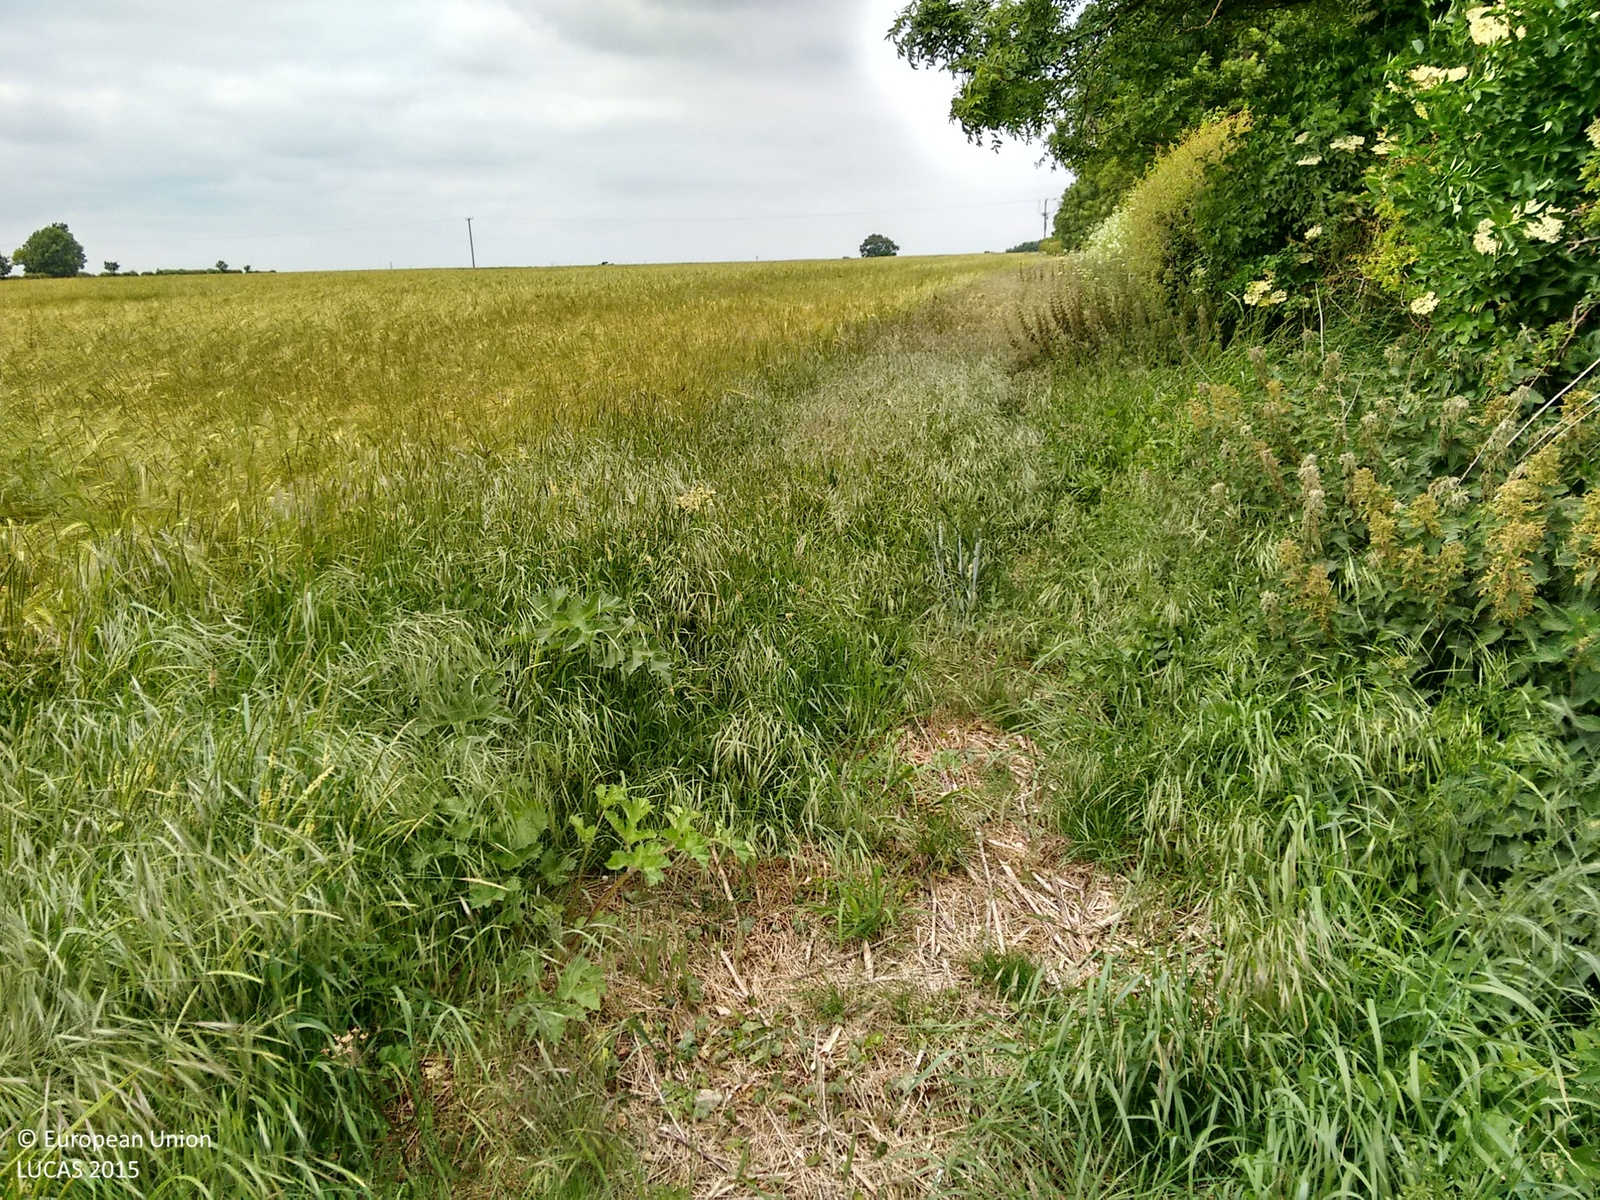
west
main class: Cropland
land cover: Barley
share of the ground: > 75 %
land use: Agriculture (excluding fallow land and kitchen gardens)
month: June
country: GB
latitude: 52.9481
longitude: -0.8619
